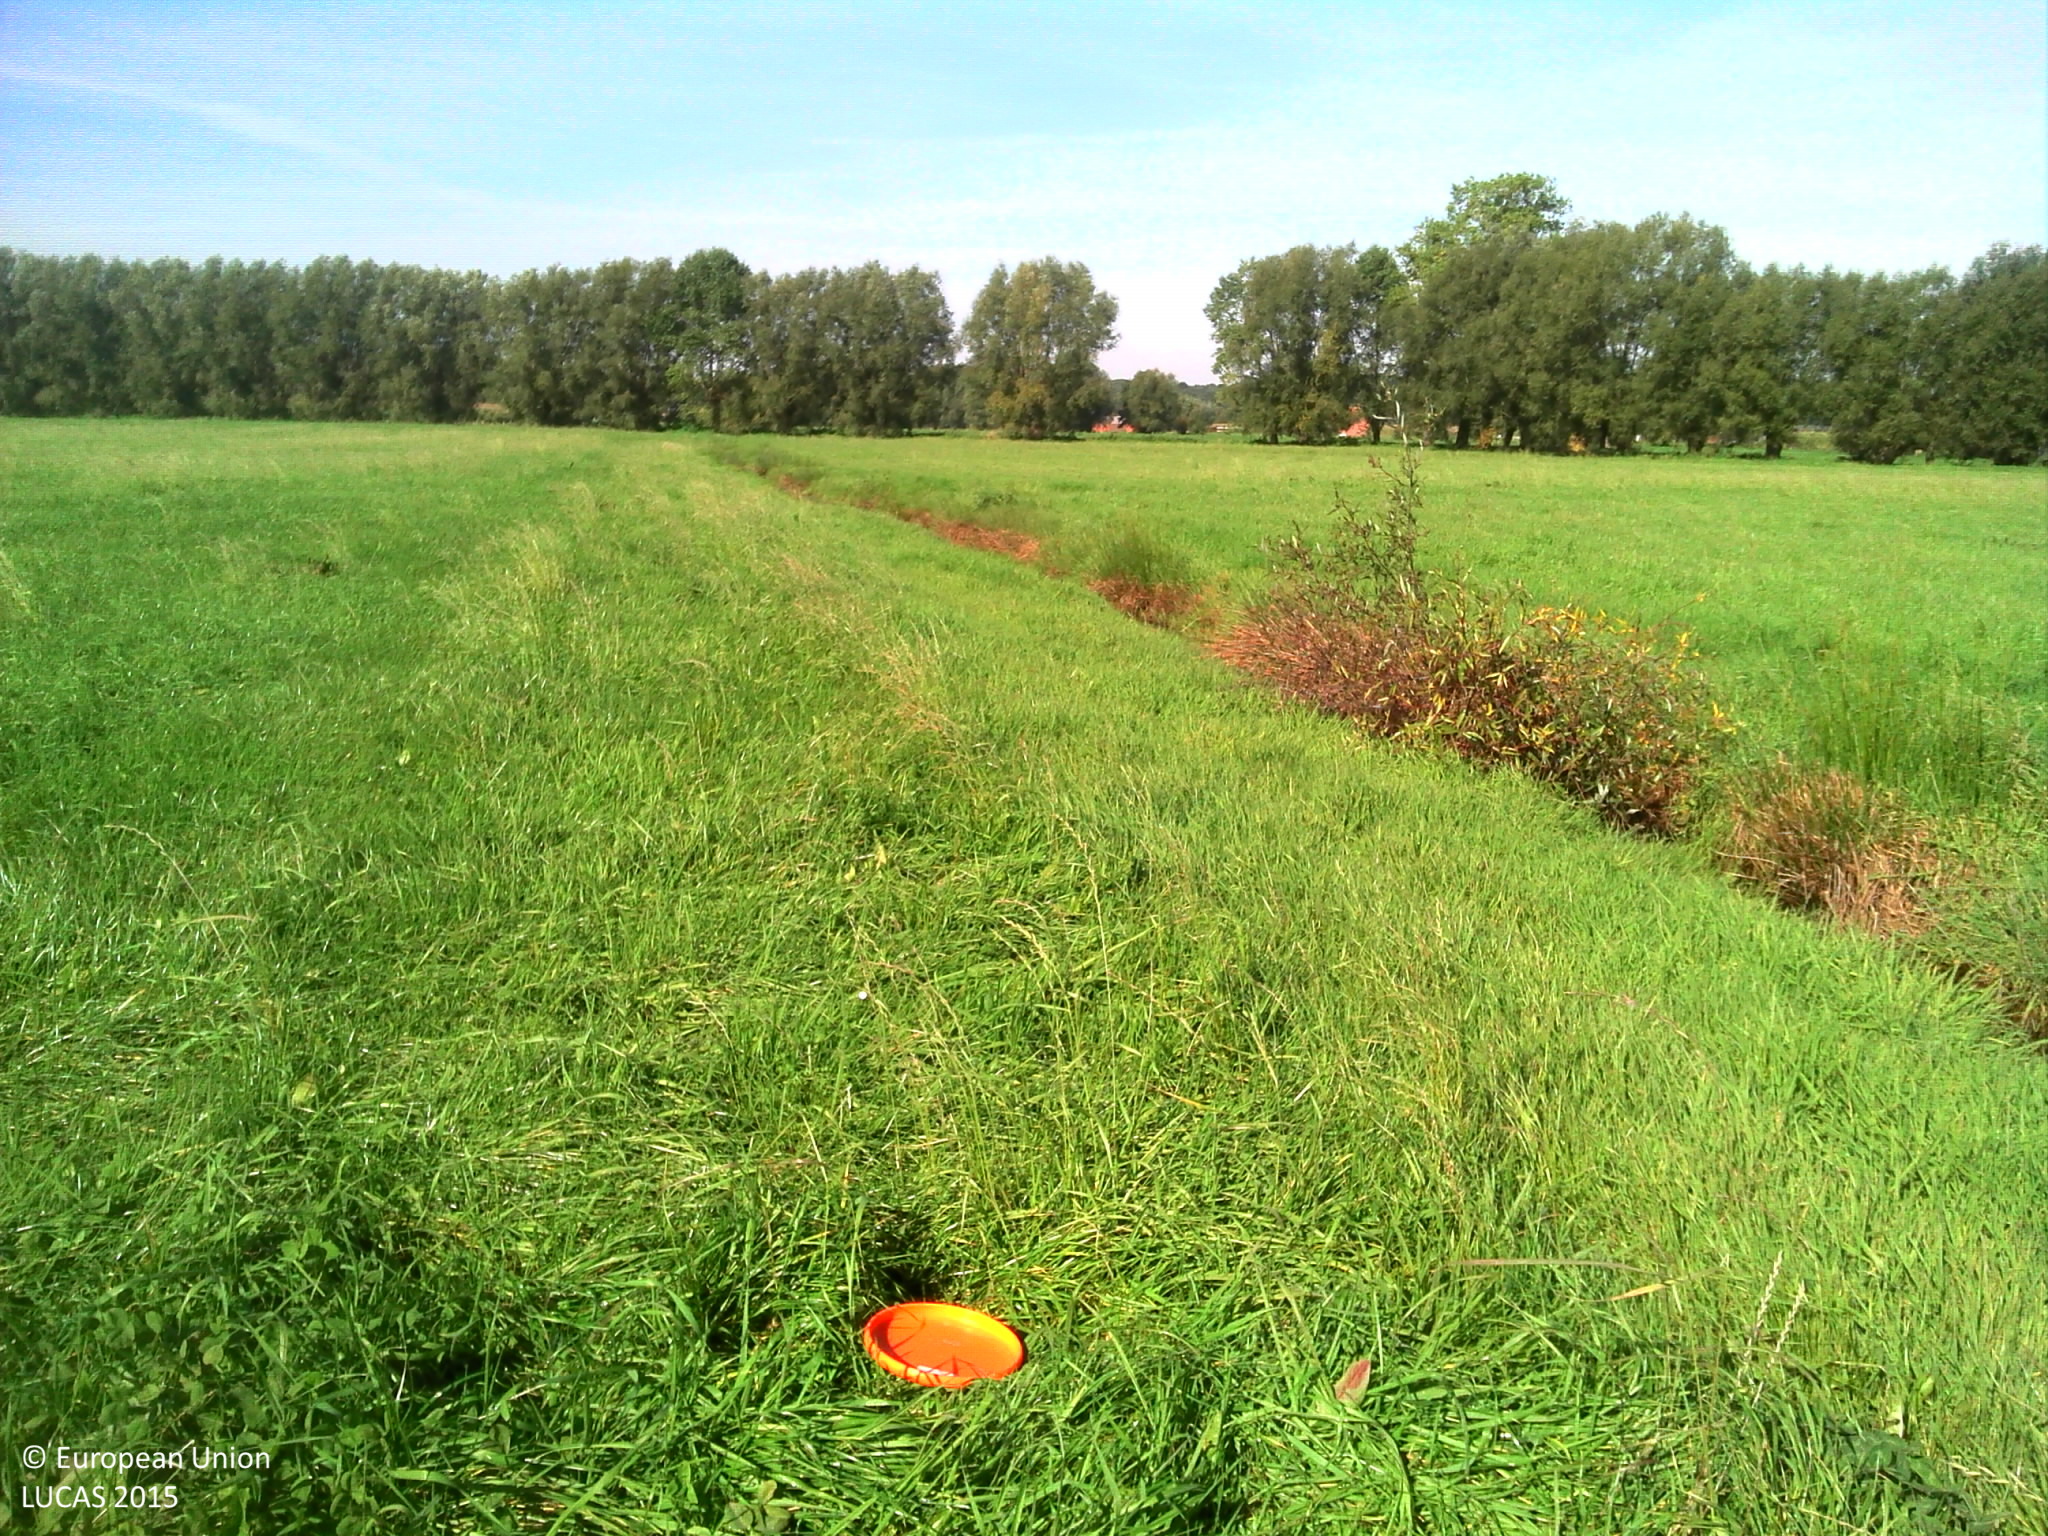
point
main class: Grassland
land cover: Grassland without tree/shrub cover
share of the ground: > 75 %
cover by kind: herbaceous plants 100 %
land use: Agriculture (excluding fallow land and kitchen gardens)
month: September
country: BE
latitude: 51.1477
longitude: 3.4016
